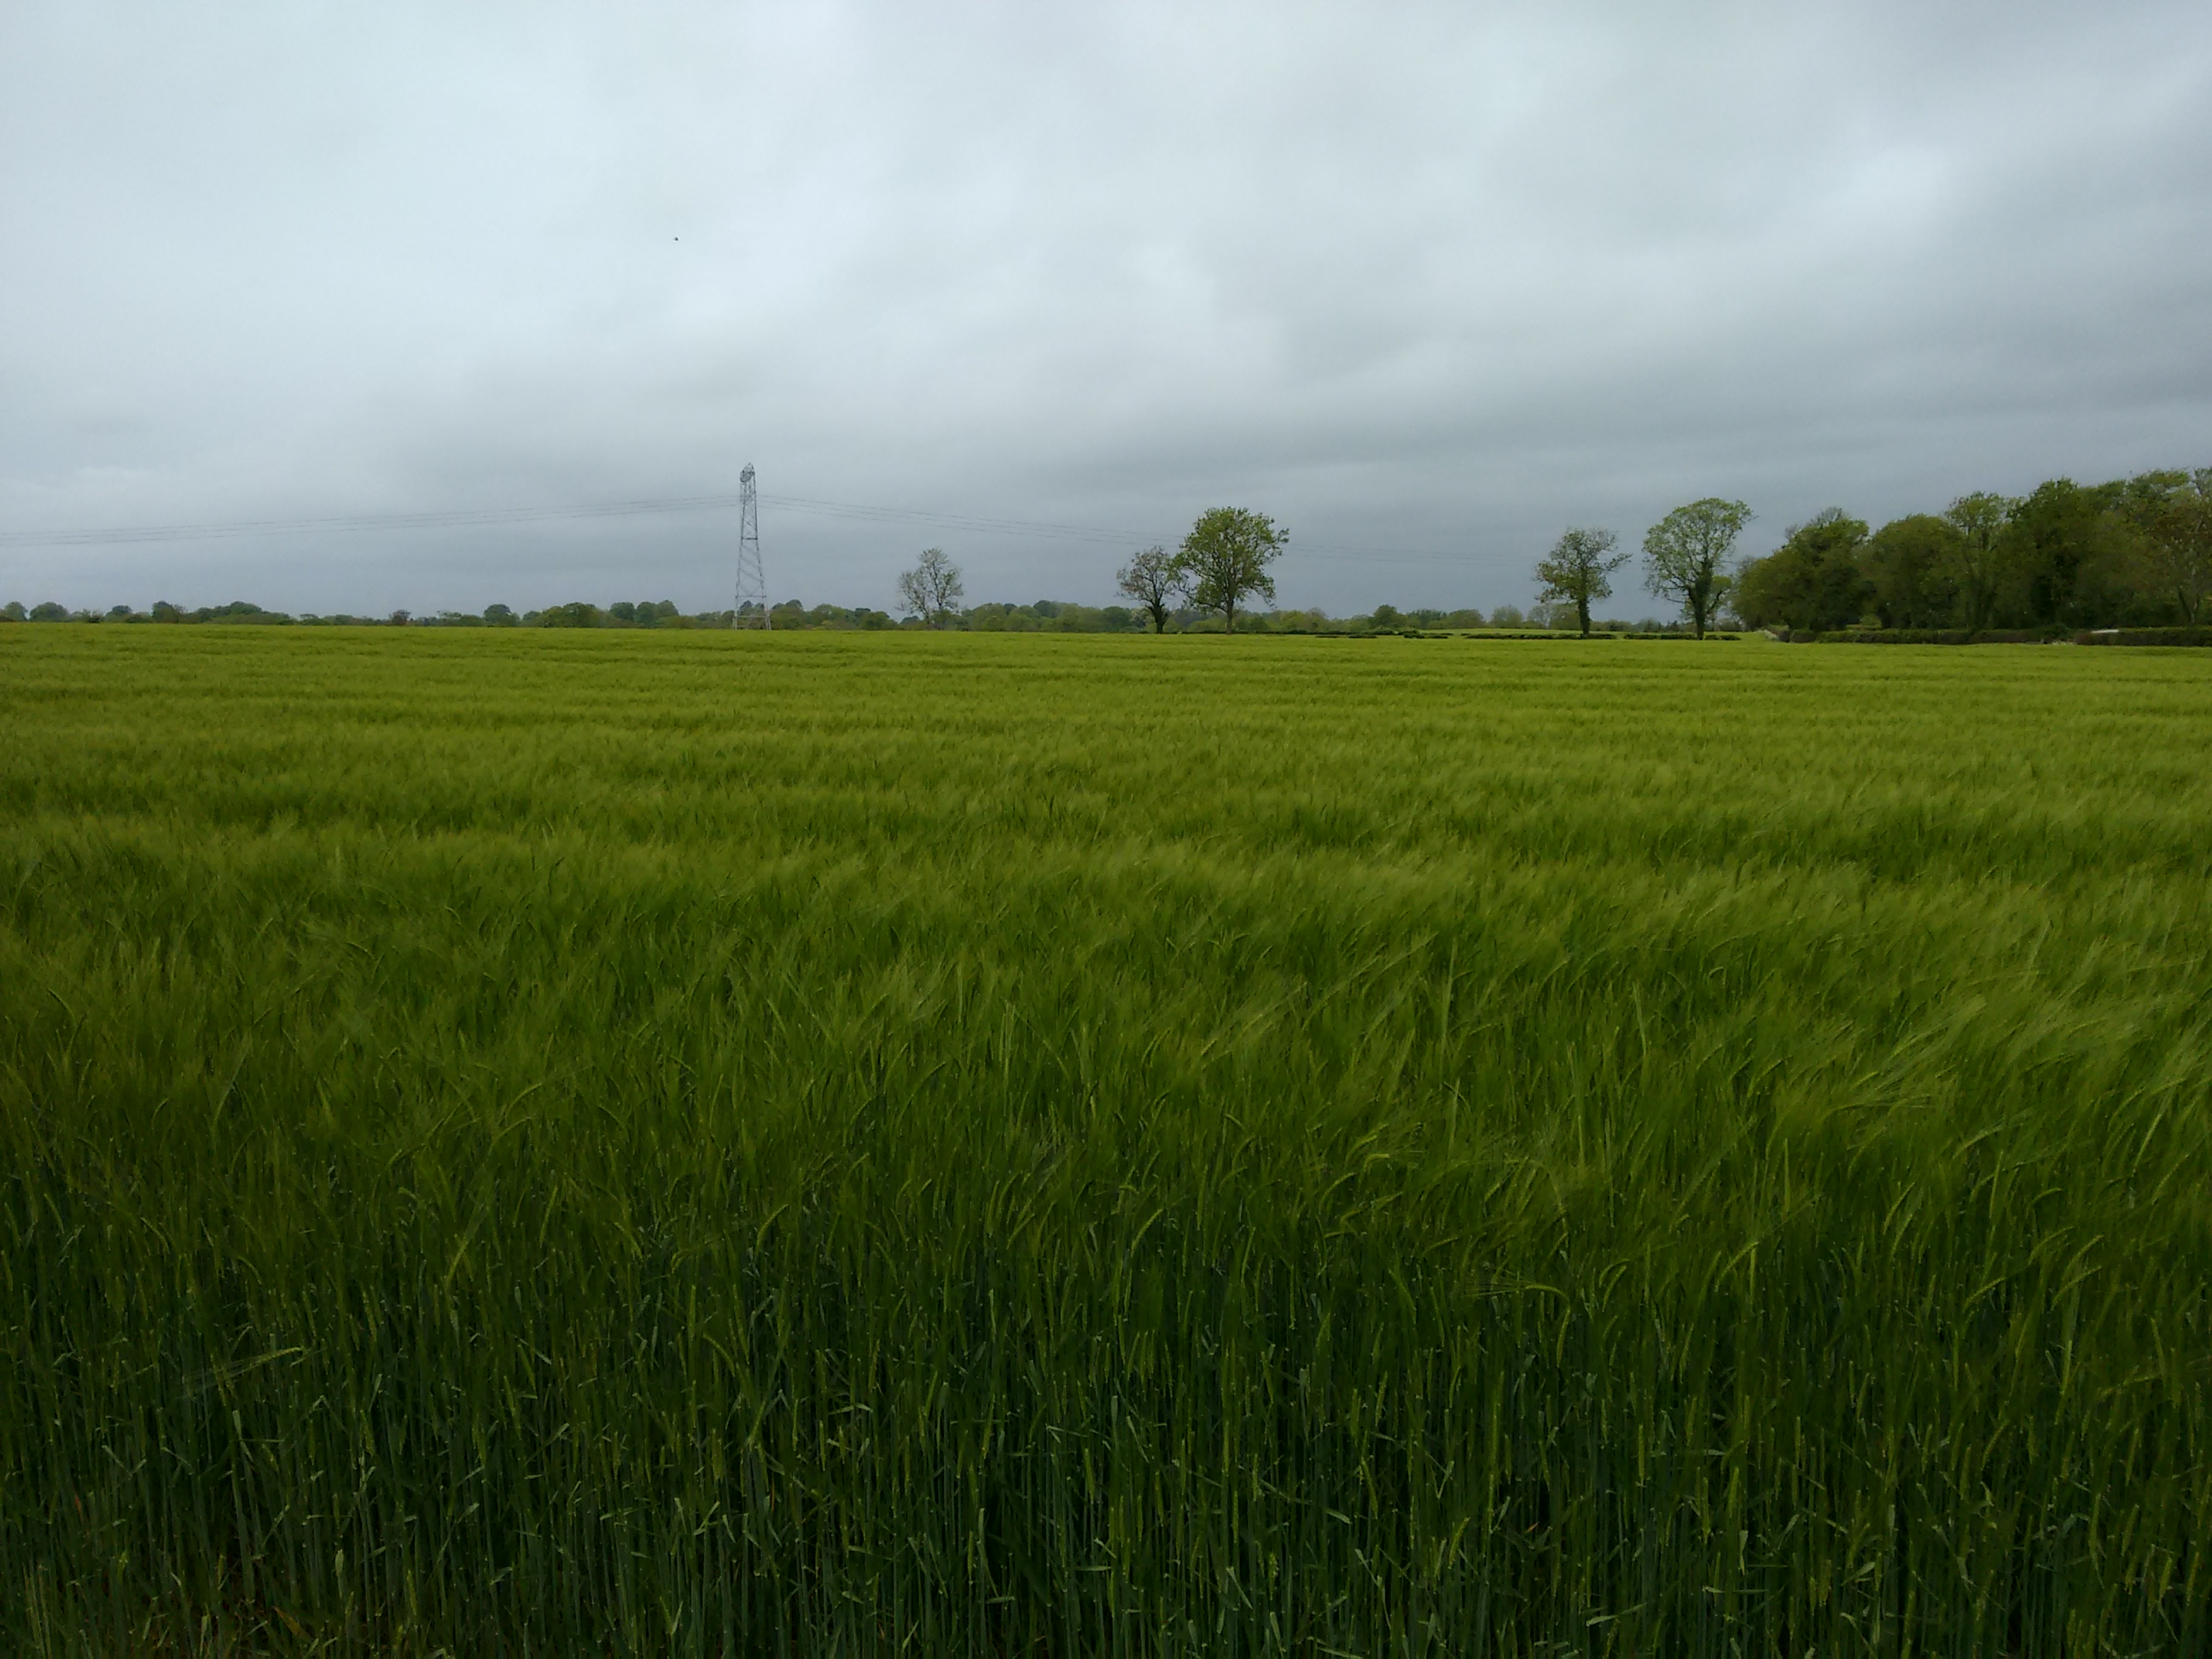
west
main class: Cropland
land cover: Barley
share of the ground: > 75 %
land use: Agriculture (excluding fallow land and kitchen gardens)
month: May
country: IE
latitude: 53.5419
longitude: -6.6551
